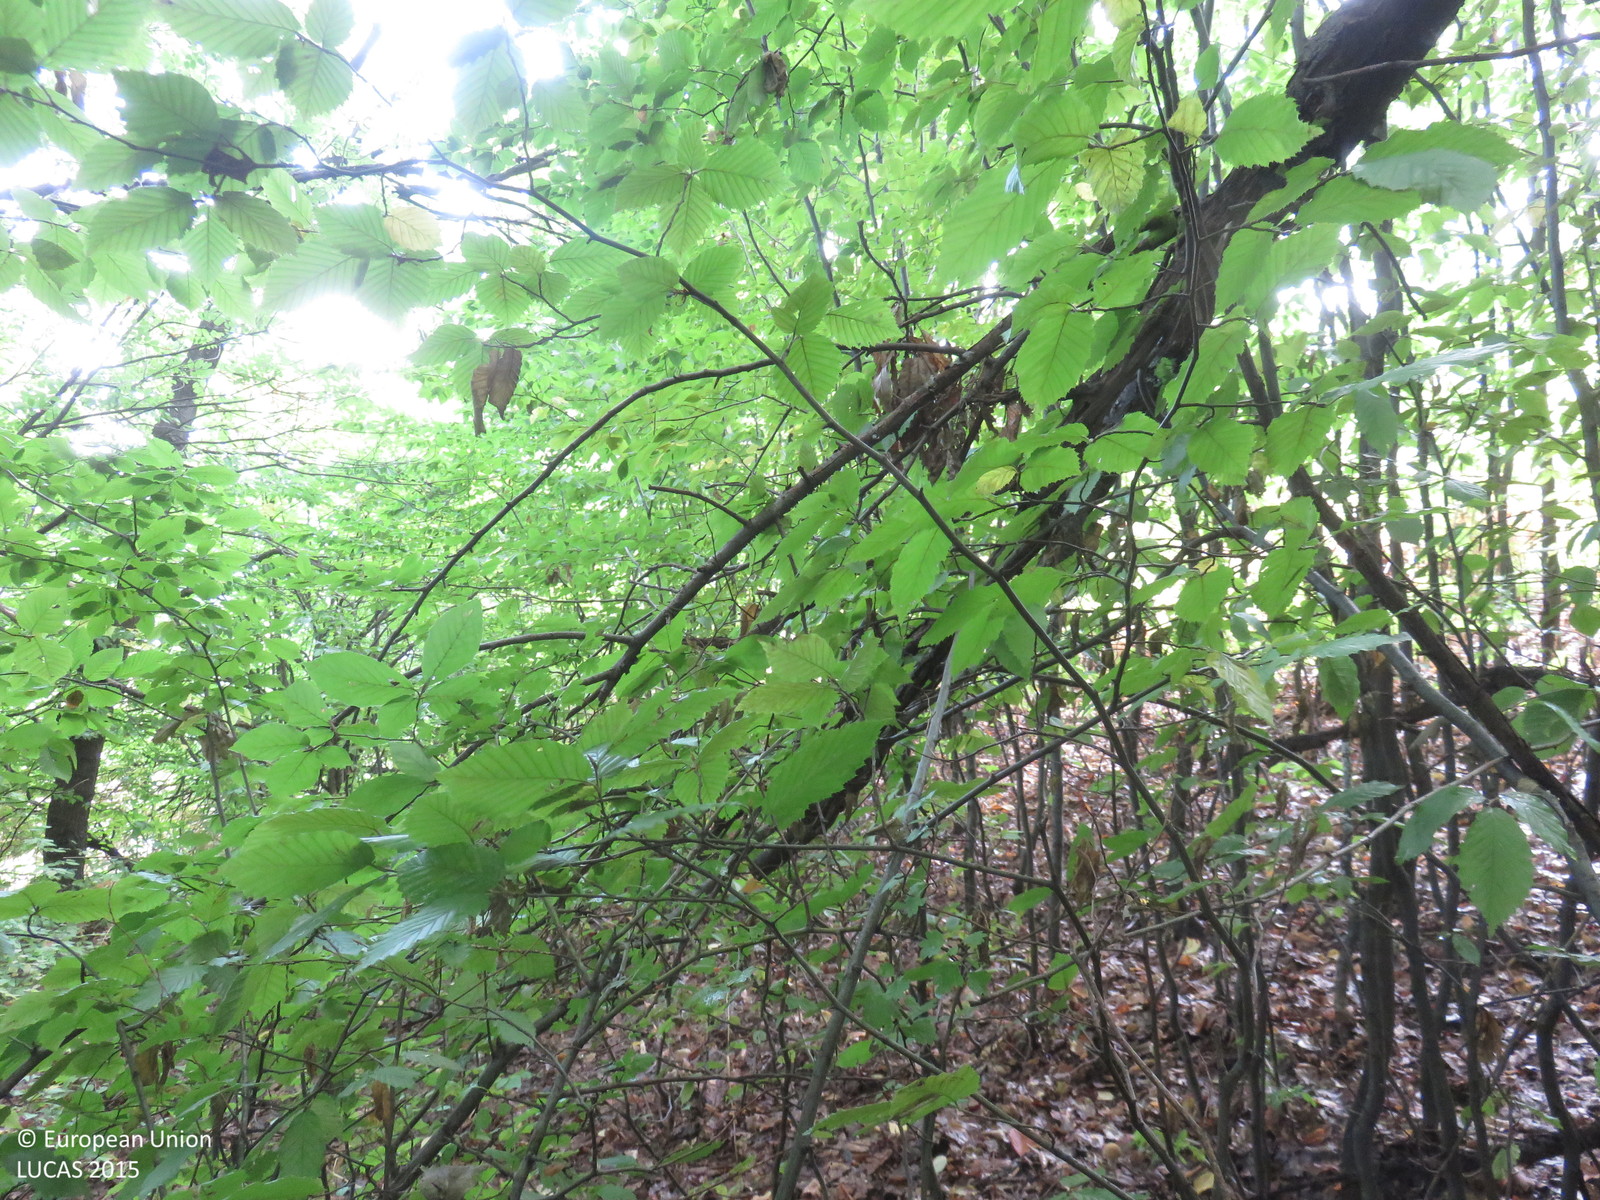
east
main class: Woodland
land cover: Broadleaved woodland
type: beech forest
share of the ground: > 75 %
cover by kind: broadleaved forest trees 95 %, unconsolidated bare surface 5 %
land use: Forestry
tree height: < 5 m
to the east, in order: Broadleaved woodland; Grassland with sparse tree/shrub cover; Tracks; Grassland with sparse tree/shrub cover; Shrubland with sparse tree cover; Broadleaved woodland; Tracks; Grassland with sparse tree/shrub cover; Tracks; Shrubland with sparse tree cover
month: October
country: BG
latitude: 42.8553
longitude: 25.2068
